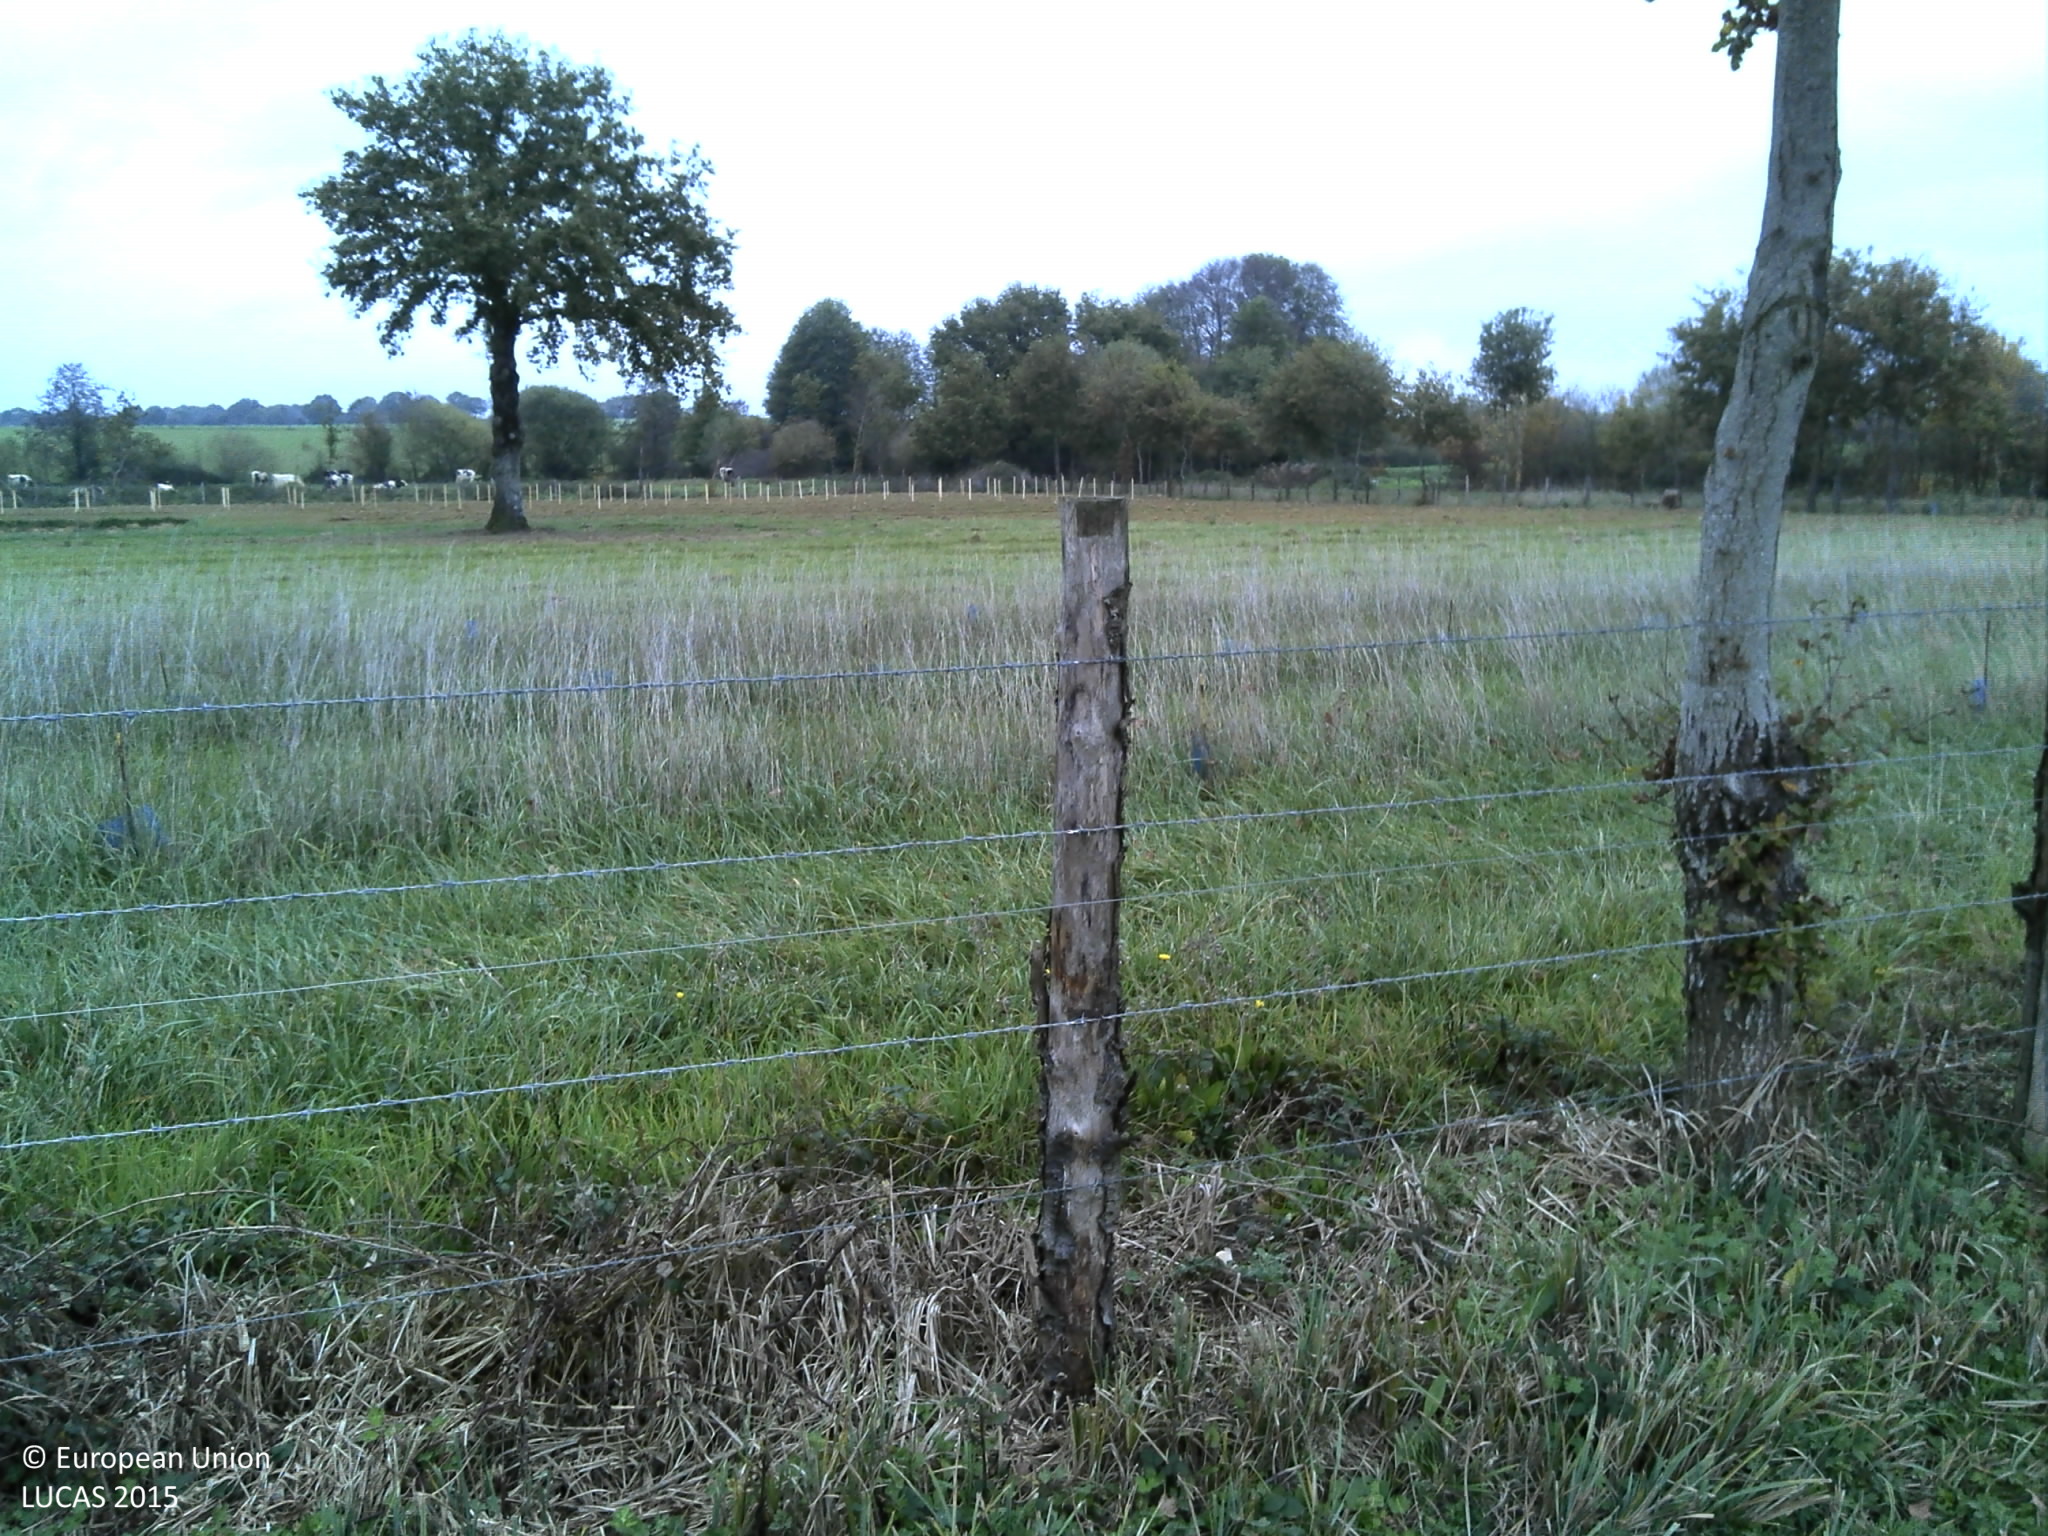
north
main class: Grassland
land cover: Grassland without tree/shrub cover
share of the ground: > 75 %
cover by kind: herbaceous plants 100 %
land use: Agriculture (excluding fallow land and kitchen gardens)
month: November
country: FR
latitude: 47.6362
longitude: -1.3412
